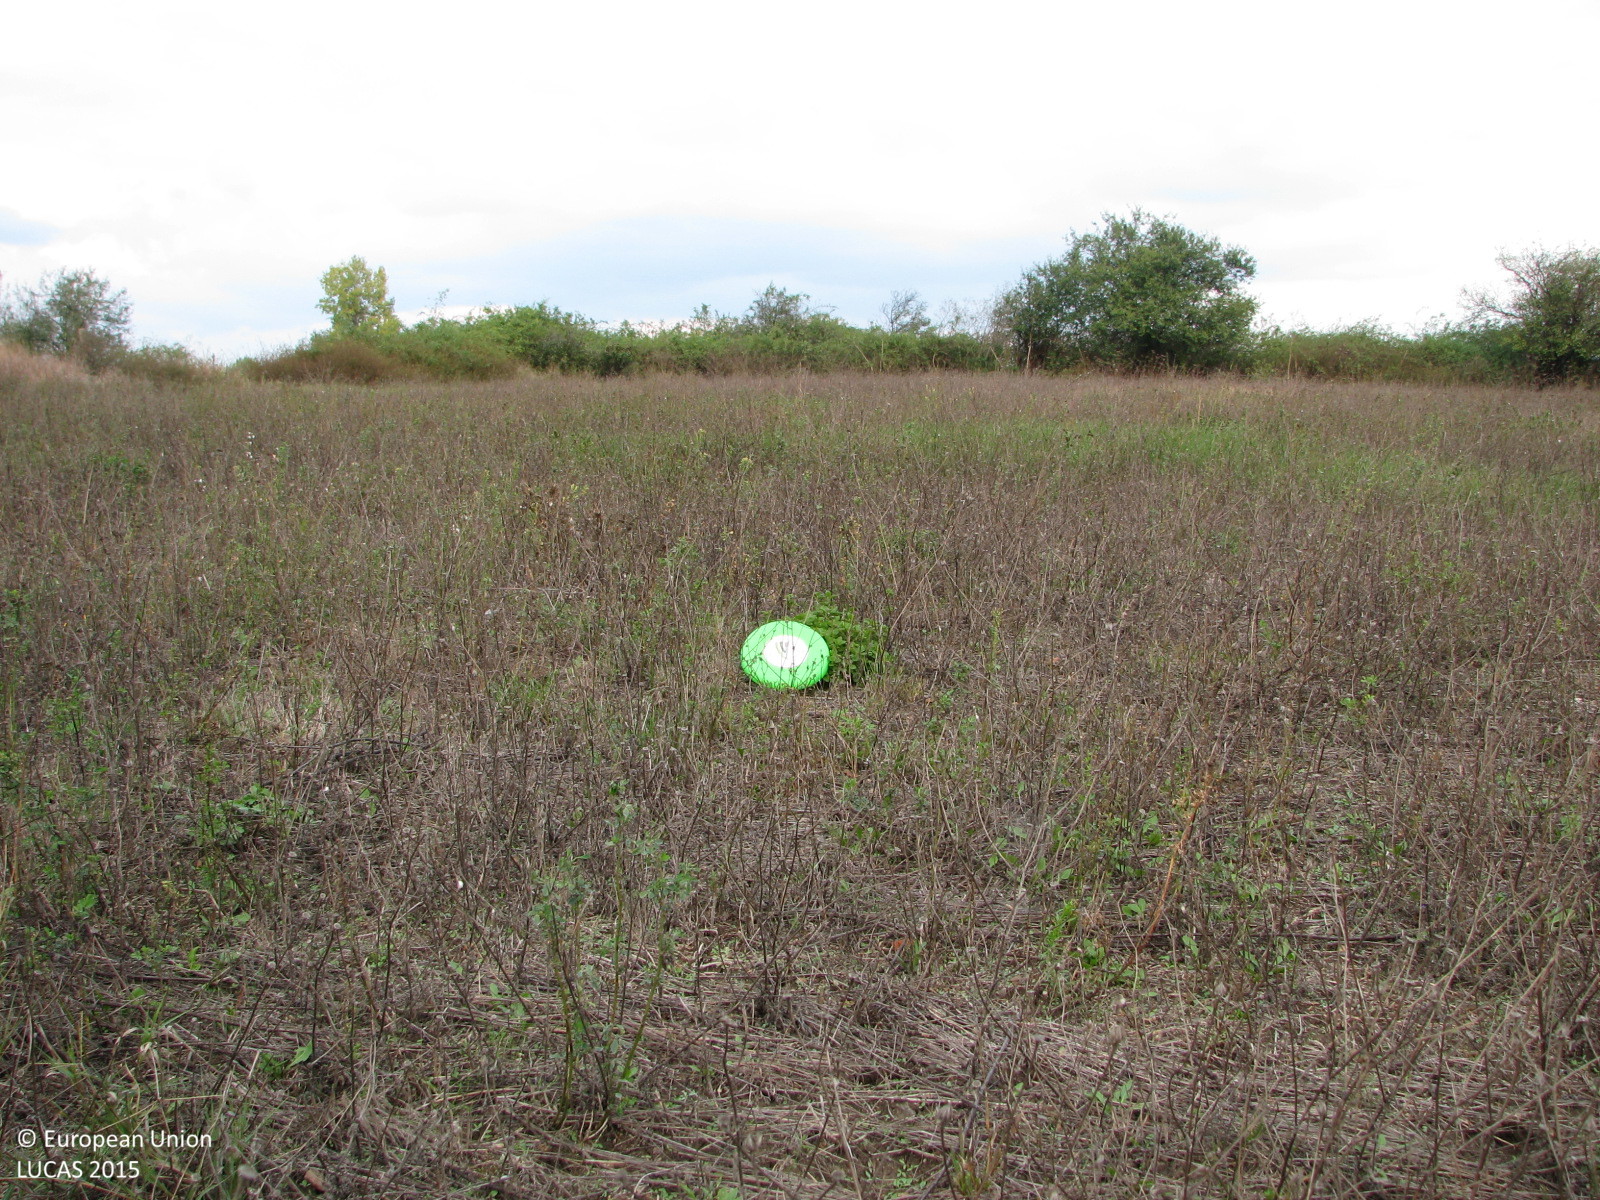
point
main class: Cropland
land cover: Lucerne
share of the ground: 25 - 50 %
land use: Agriculture (excluding fallow land and kitchen gardens)
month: October
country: BG
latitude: 42.2797
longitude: 26.5207
